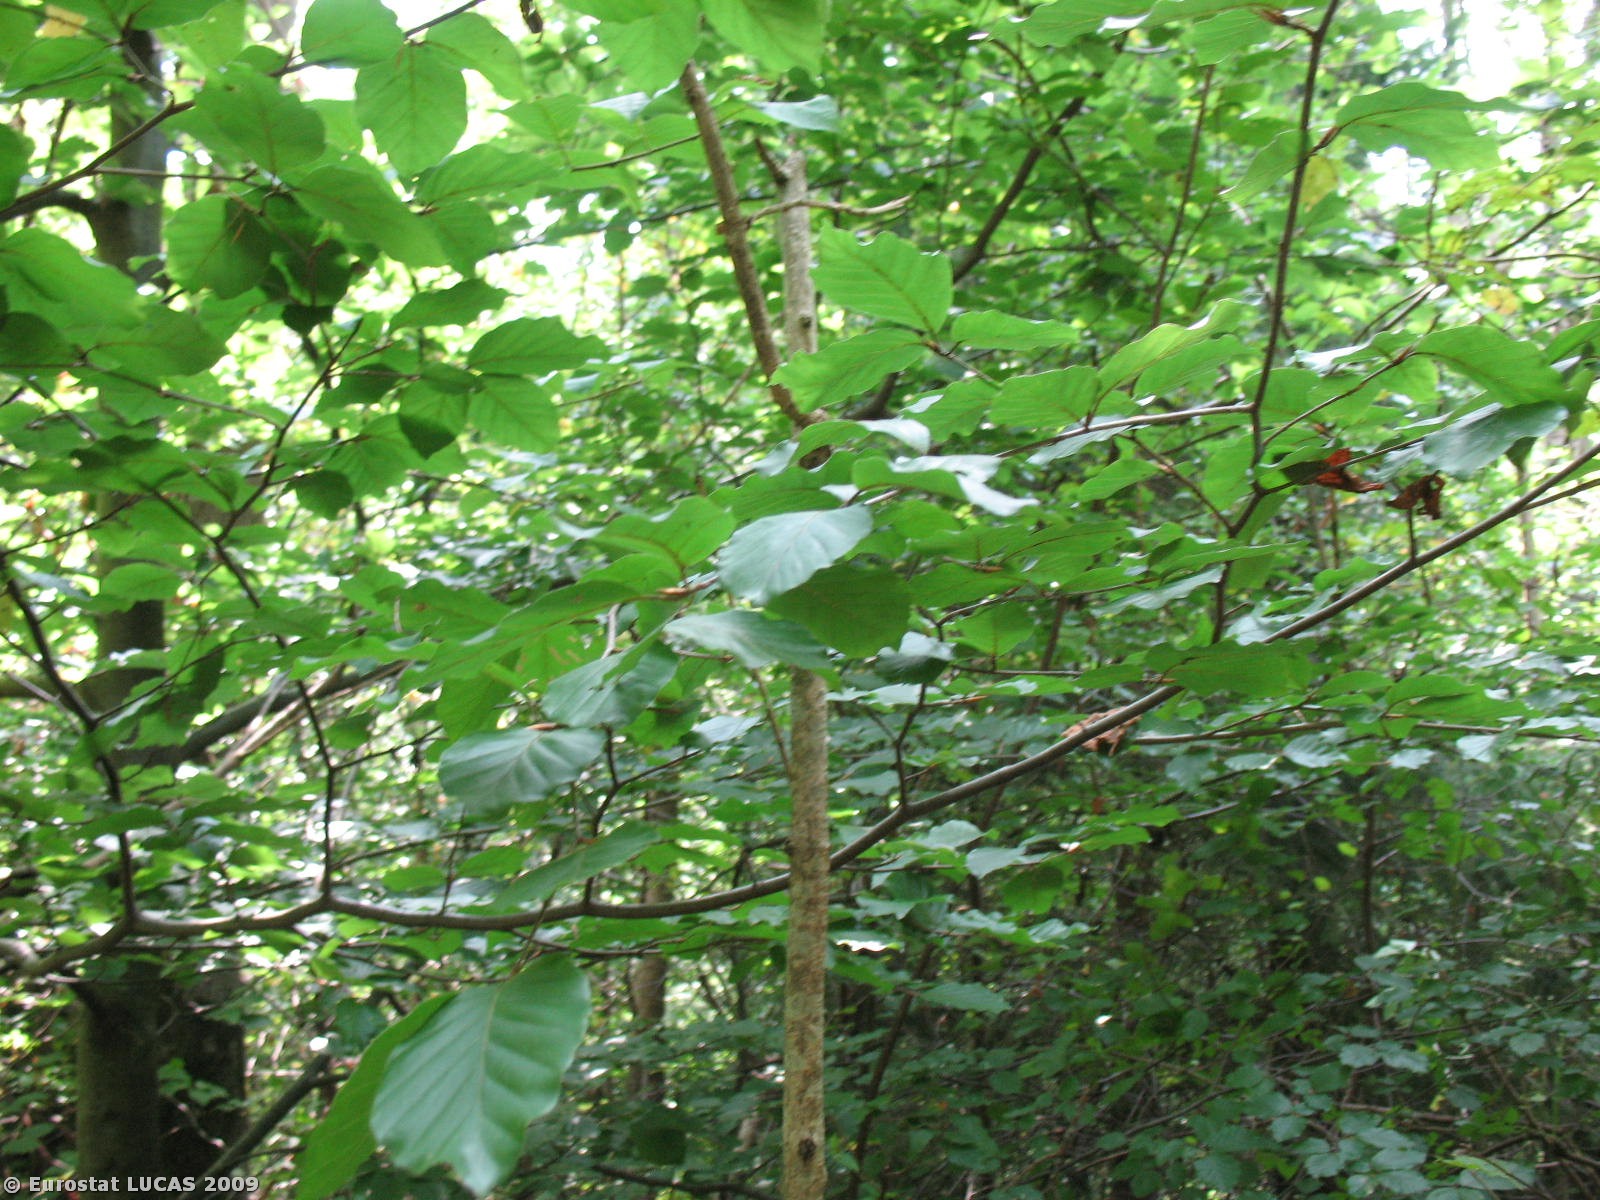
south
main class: Woodland
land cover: Mixed woodland
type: hemiboreal forest and nemoral coniferous forest and mixed broadleaved-coniferous forest
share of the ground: > 75 %
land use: Forestry
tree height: > 5 m
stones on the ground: < 10 %
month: August
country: PL
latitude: 49.3157
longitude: 22.4577
